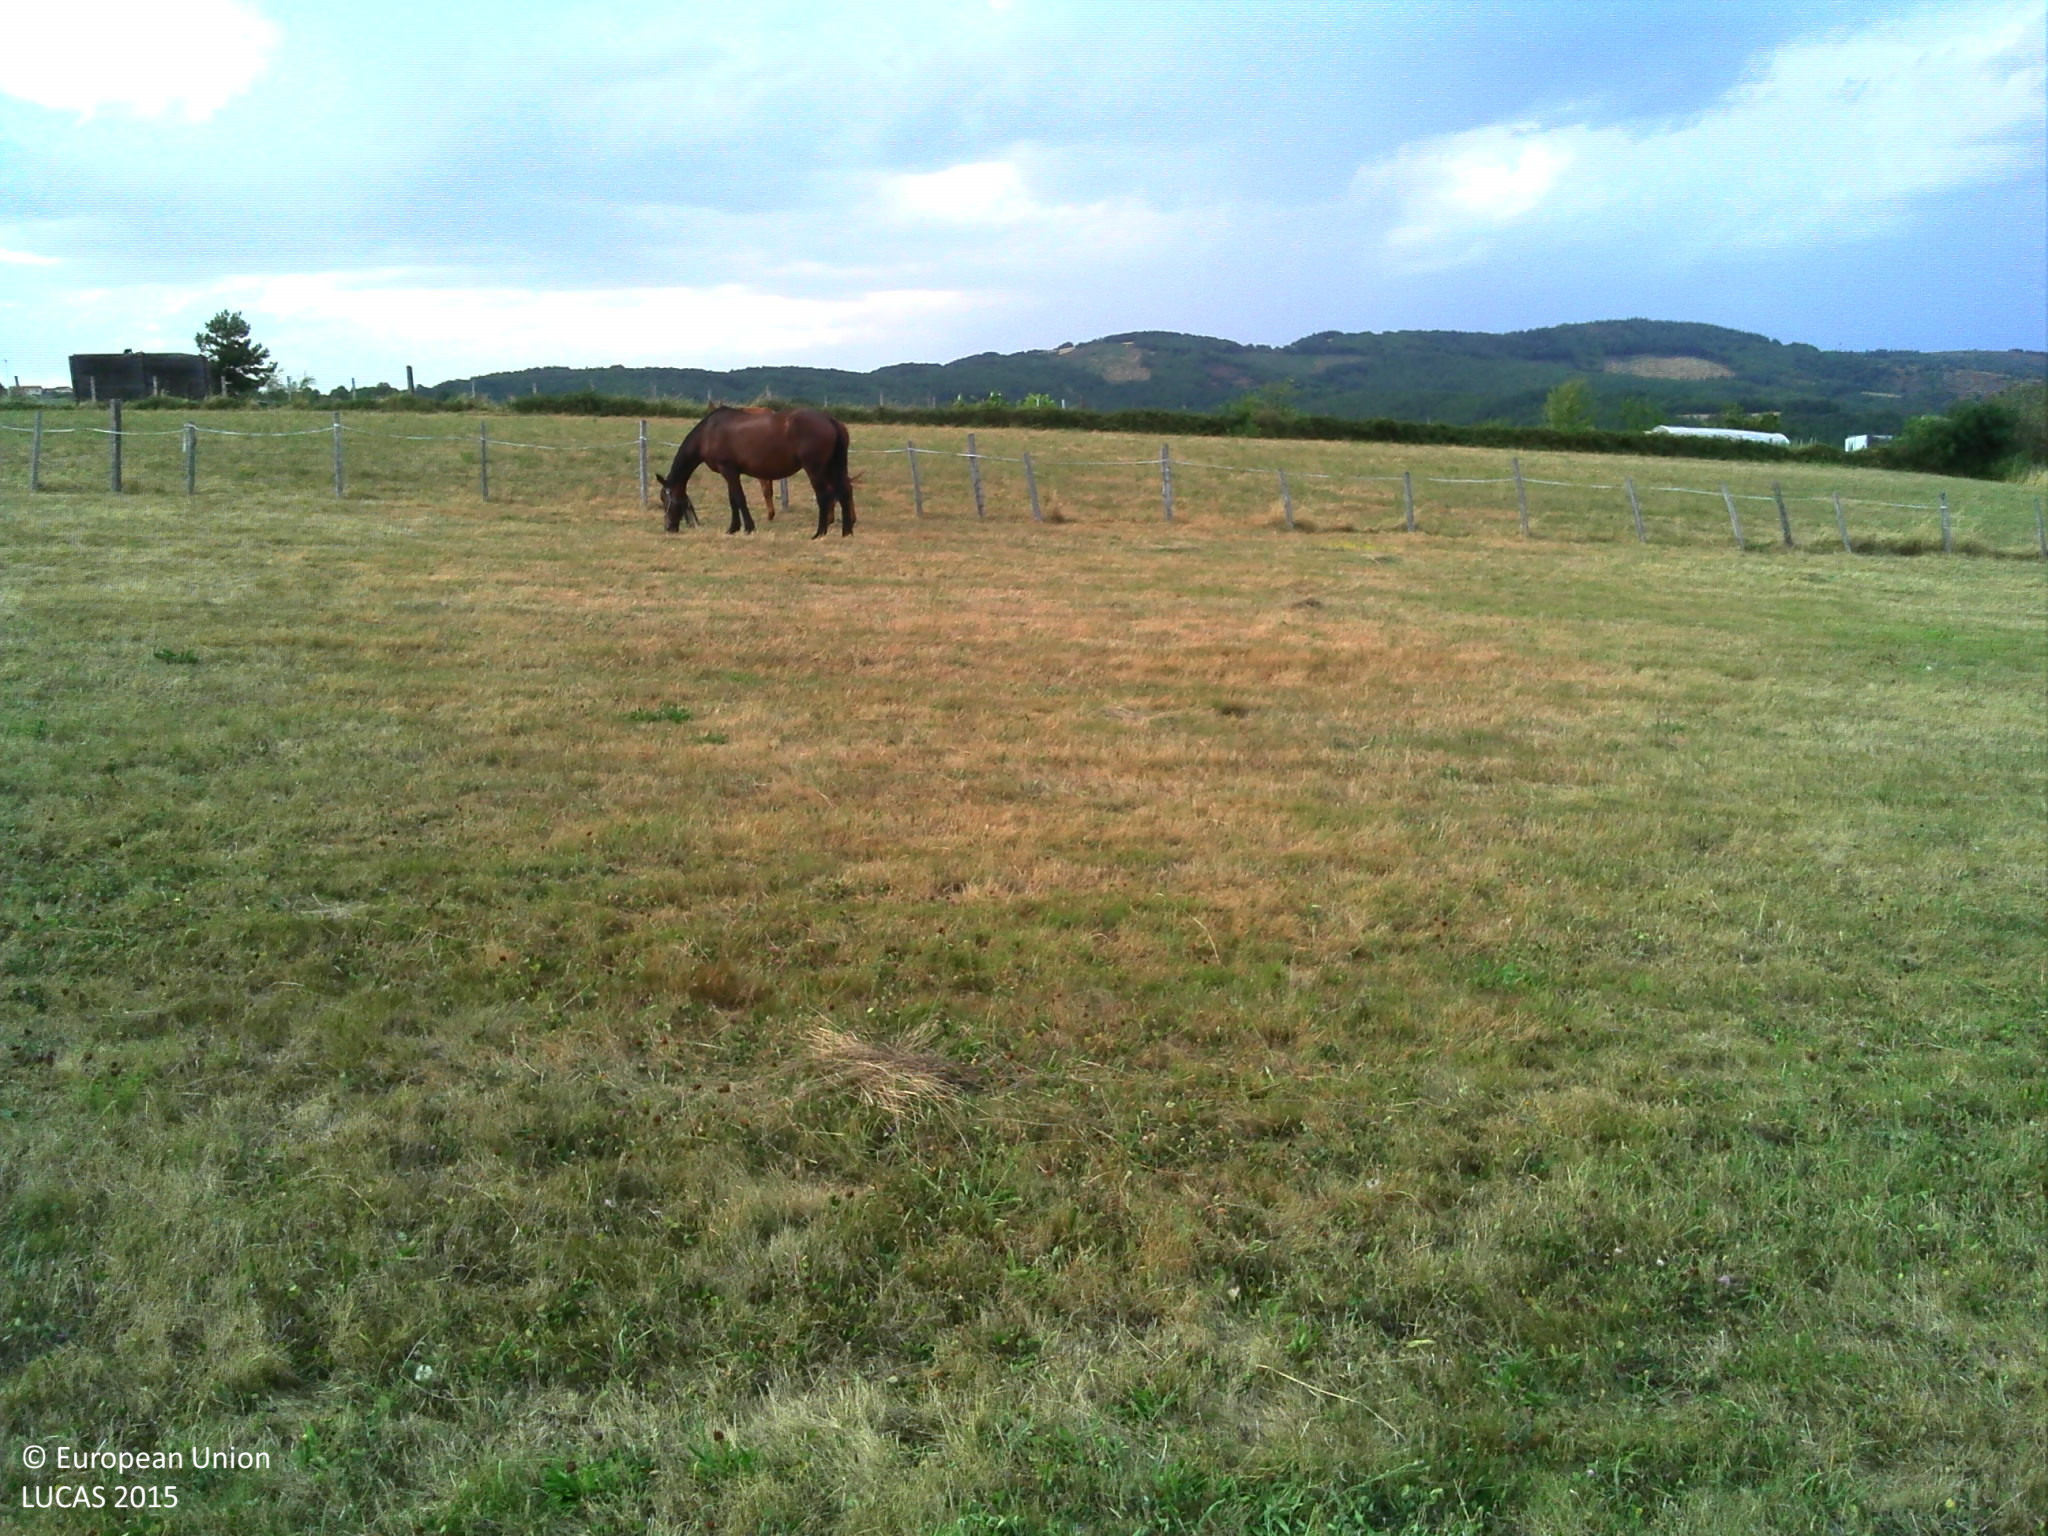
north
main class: Grassland
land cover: Grassland without tree/shrub cover
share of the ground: > 75 %
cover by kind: herbaceous plants 100 %
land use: Agriculture (excluding fallow land and kitchen gardens)
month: August
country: FR
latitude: 45.4869
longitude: 4.4893
